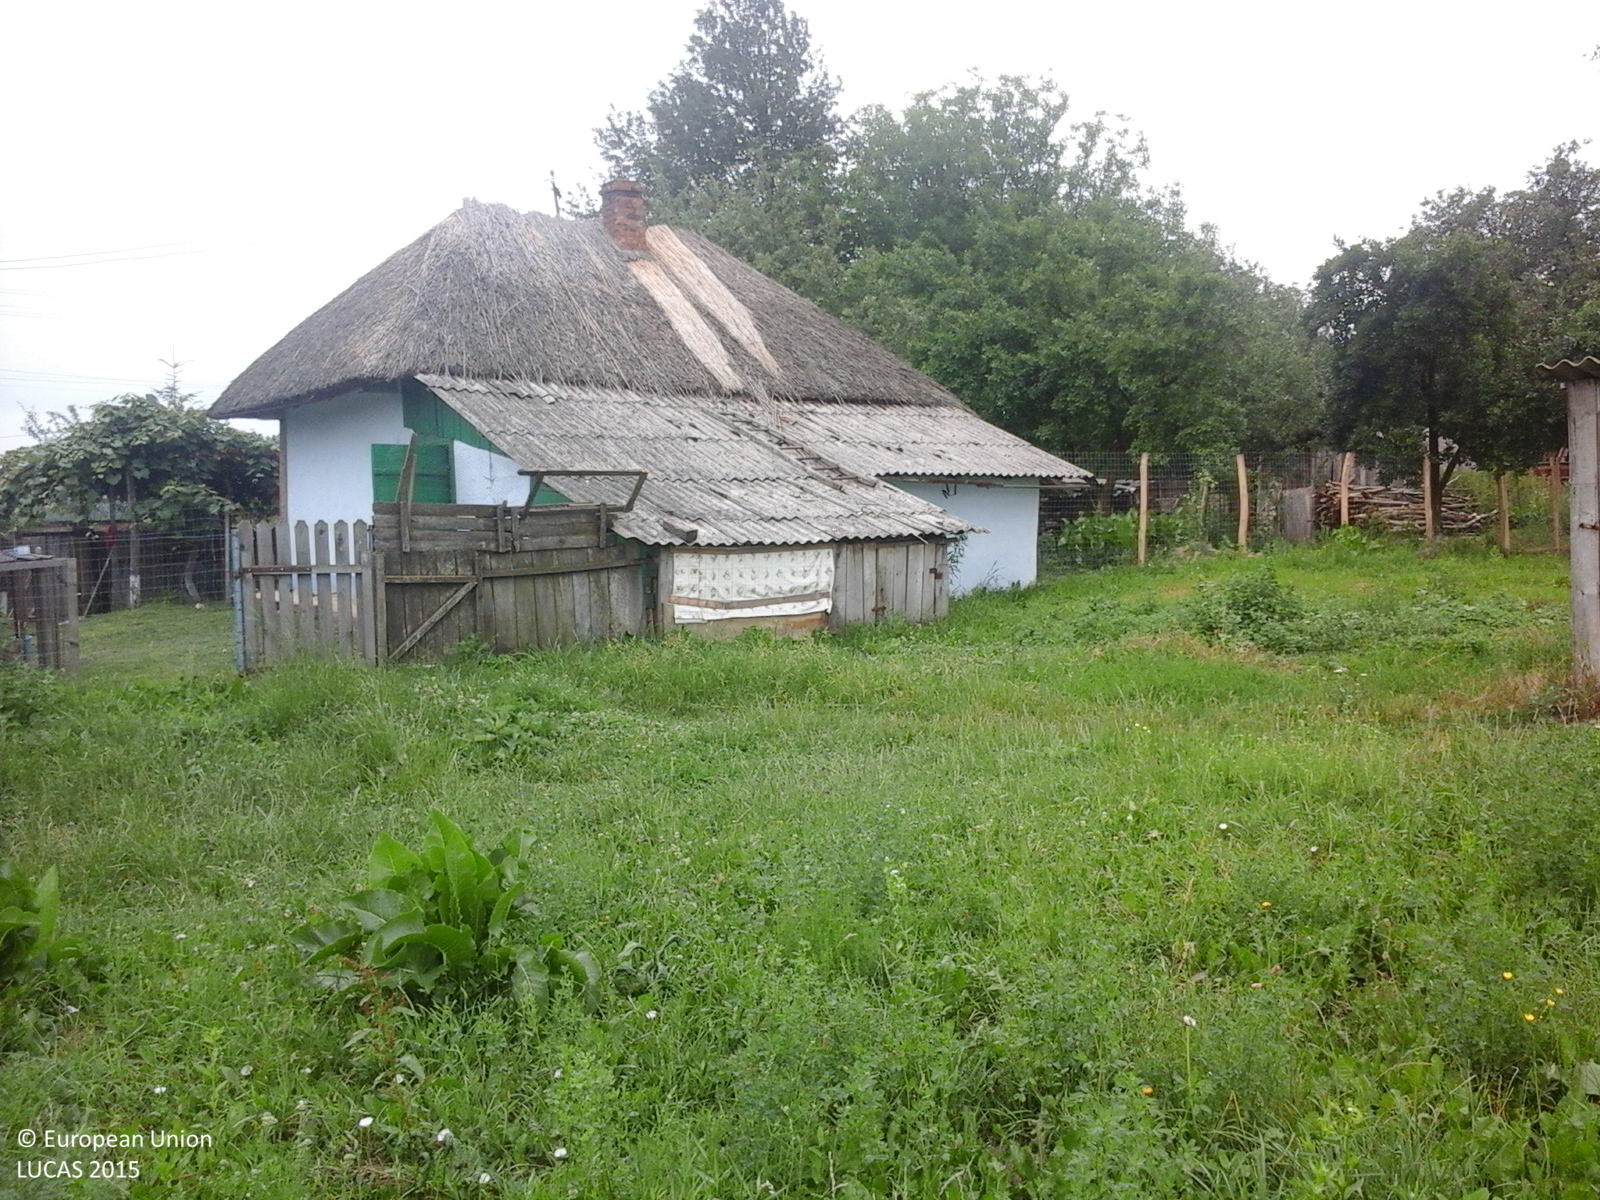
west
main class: Cropland
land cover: Potatoes
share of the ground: > 75 %
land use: Agriculture (excluding fallow land and kitchen gardens)
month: June
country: RO
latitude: 48.1206
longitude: 26.4124
